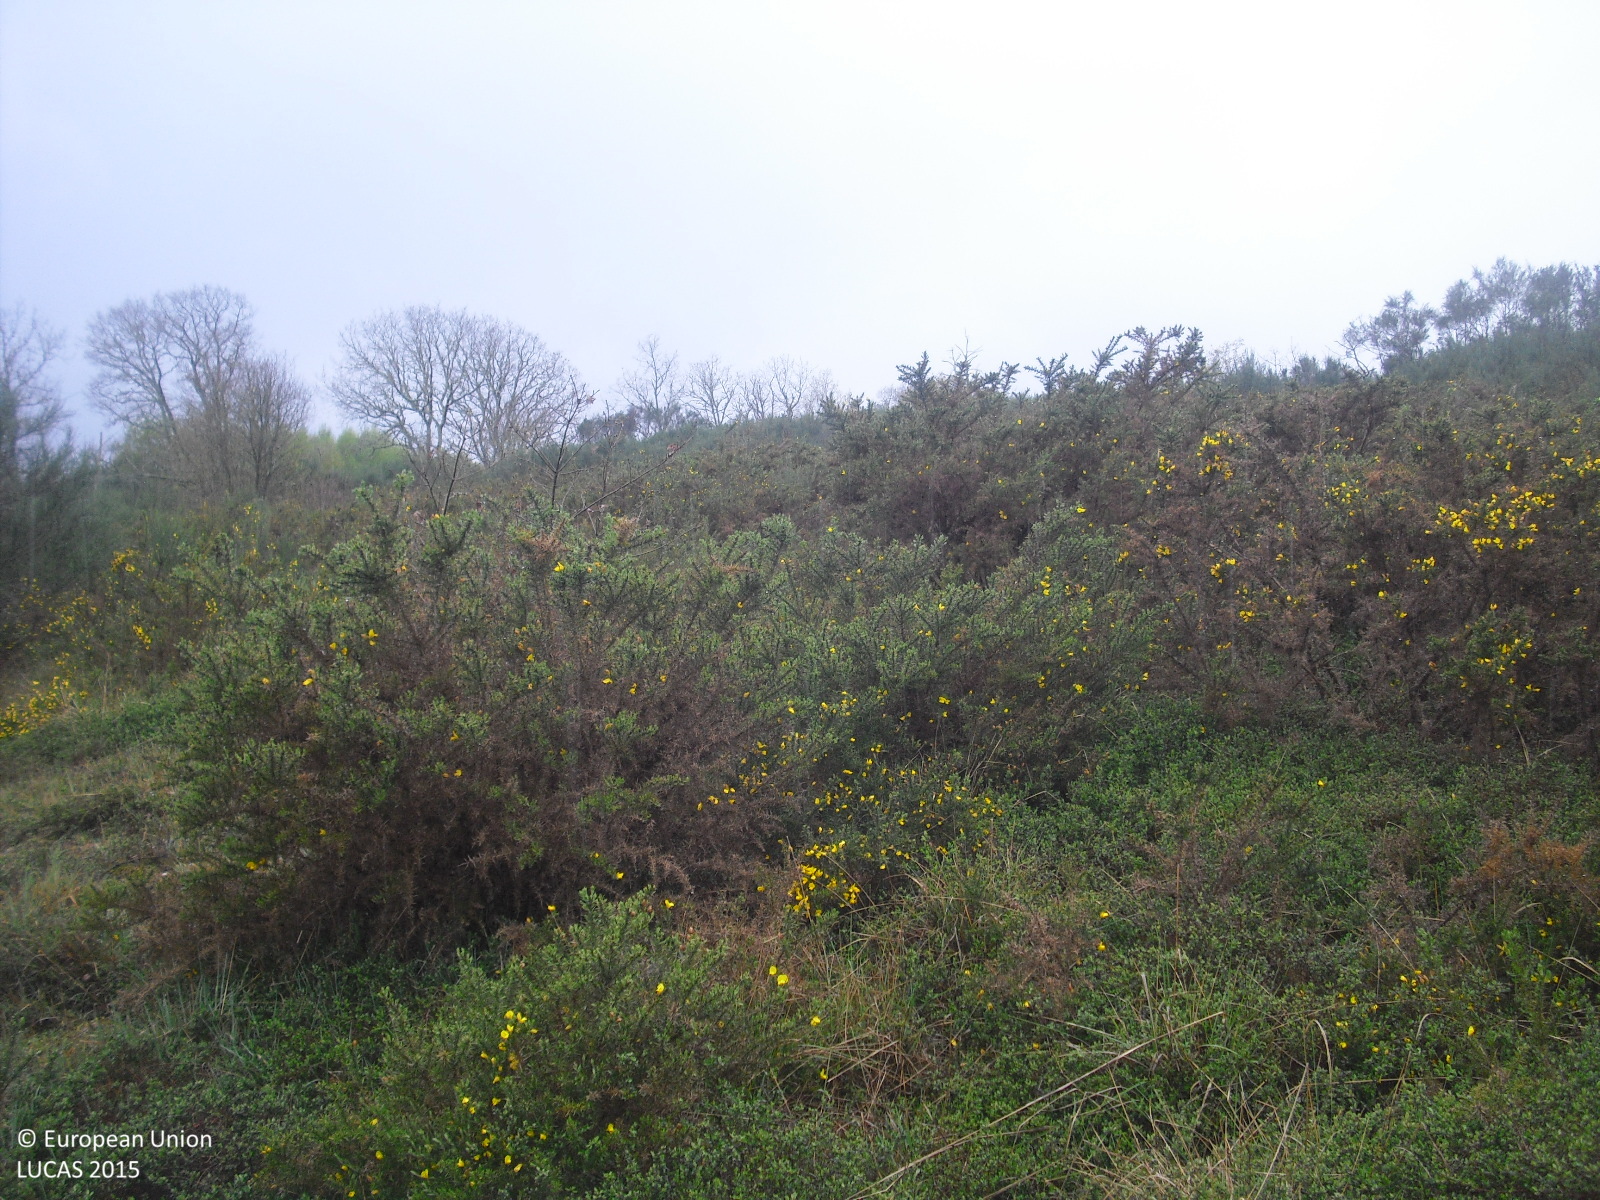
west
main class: Shrubland
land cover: Shrubland with sparse tree cover
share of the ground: 50 - 75 %
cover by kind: shrubs 85 %, herbaceous plants 10 %, broadleaved forest trees 5 %
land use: Abandoned areas
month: April
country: ES
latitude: 42.1203
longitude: -7.8668
